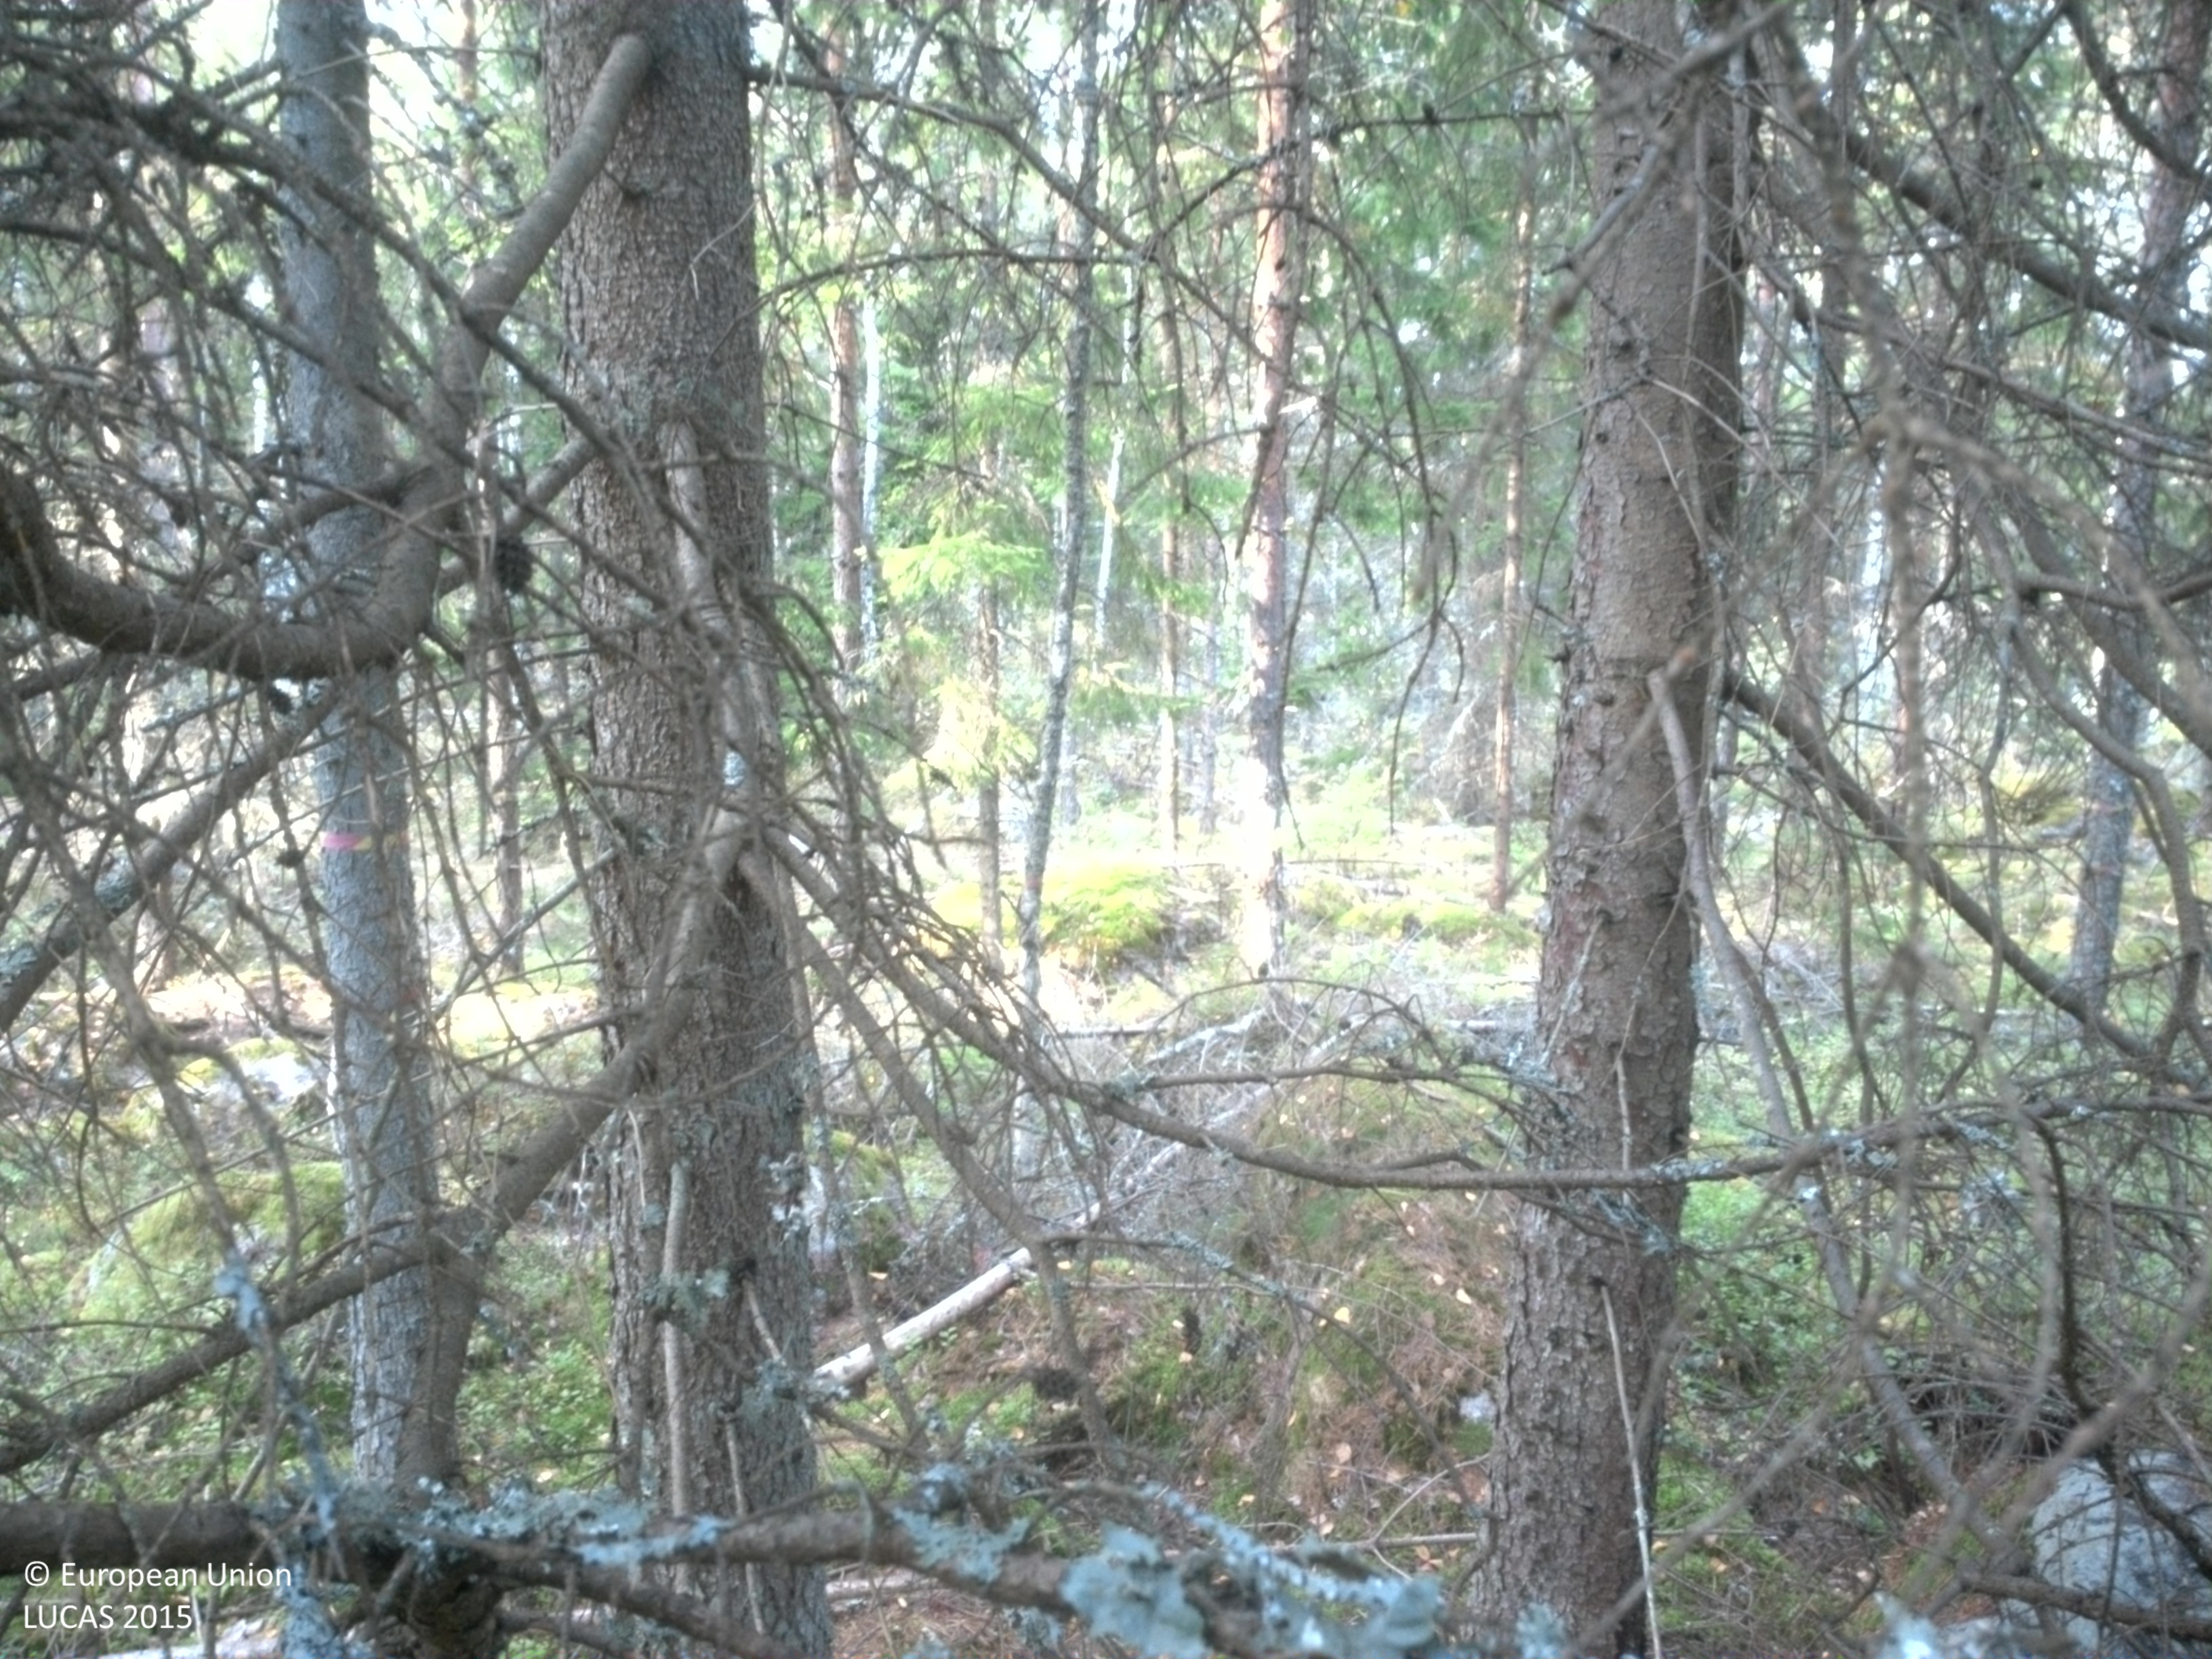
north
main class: Woodland
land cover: Spruce dominated mixed woodland
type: boreal forest
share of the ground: 50 - 75 %
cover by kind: coniferous forest trees 40 %, broadleaved forest trees 25 %, shrubs 20 %, lichens and mosses 10 %, consolidated bare surface 5 %
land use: Forestry
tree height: > 5 m
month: September
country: SE
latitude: 59.5338
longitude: 15.4547
